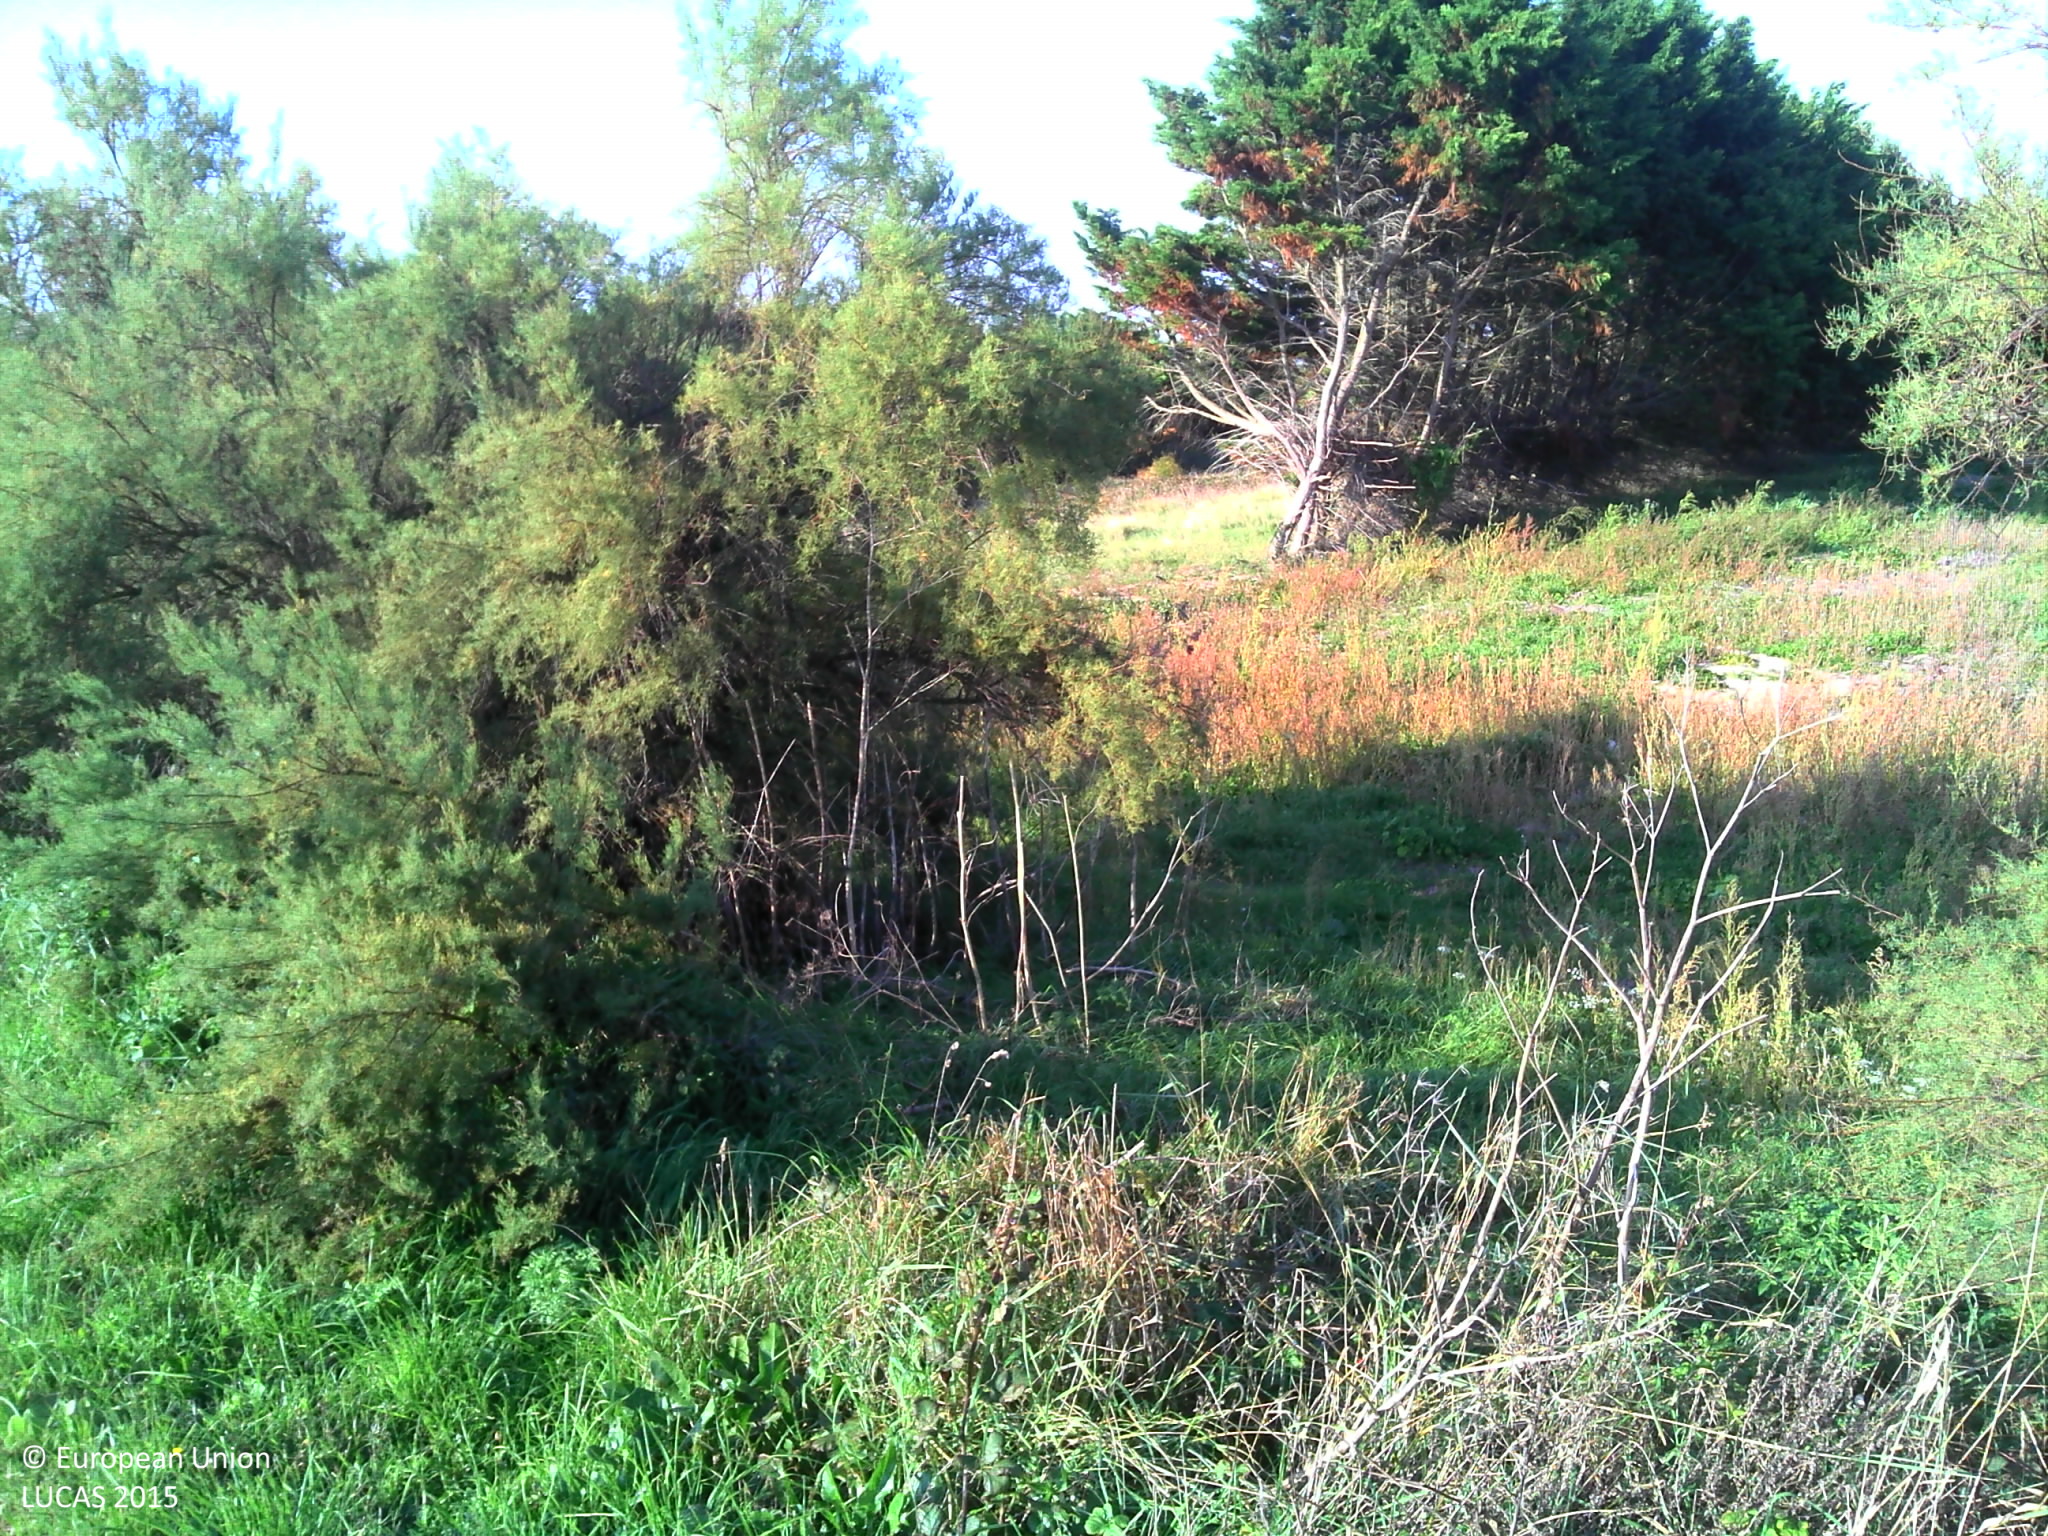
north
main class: Woodland
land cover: Other coniferous woodland
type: exotic forest
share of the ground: > 75 %
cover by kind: coniferous forest trees 85 %, herbaceous plants 15 %
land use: Road transport
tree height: < 5 m
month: October
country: FR
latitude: 46.2996
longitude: -1.2639
